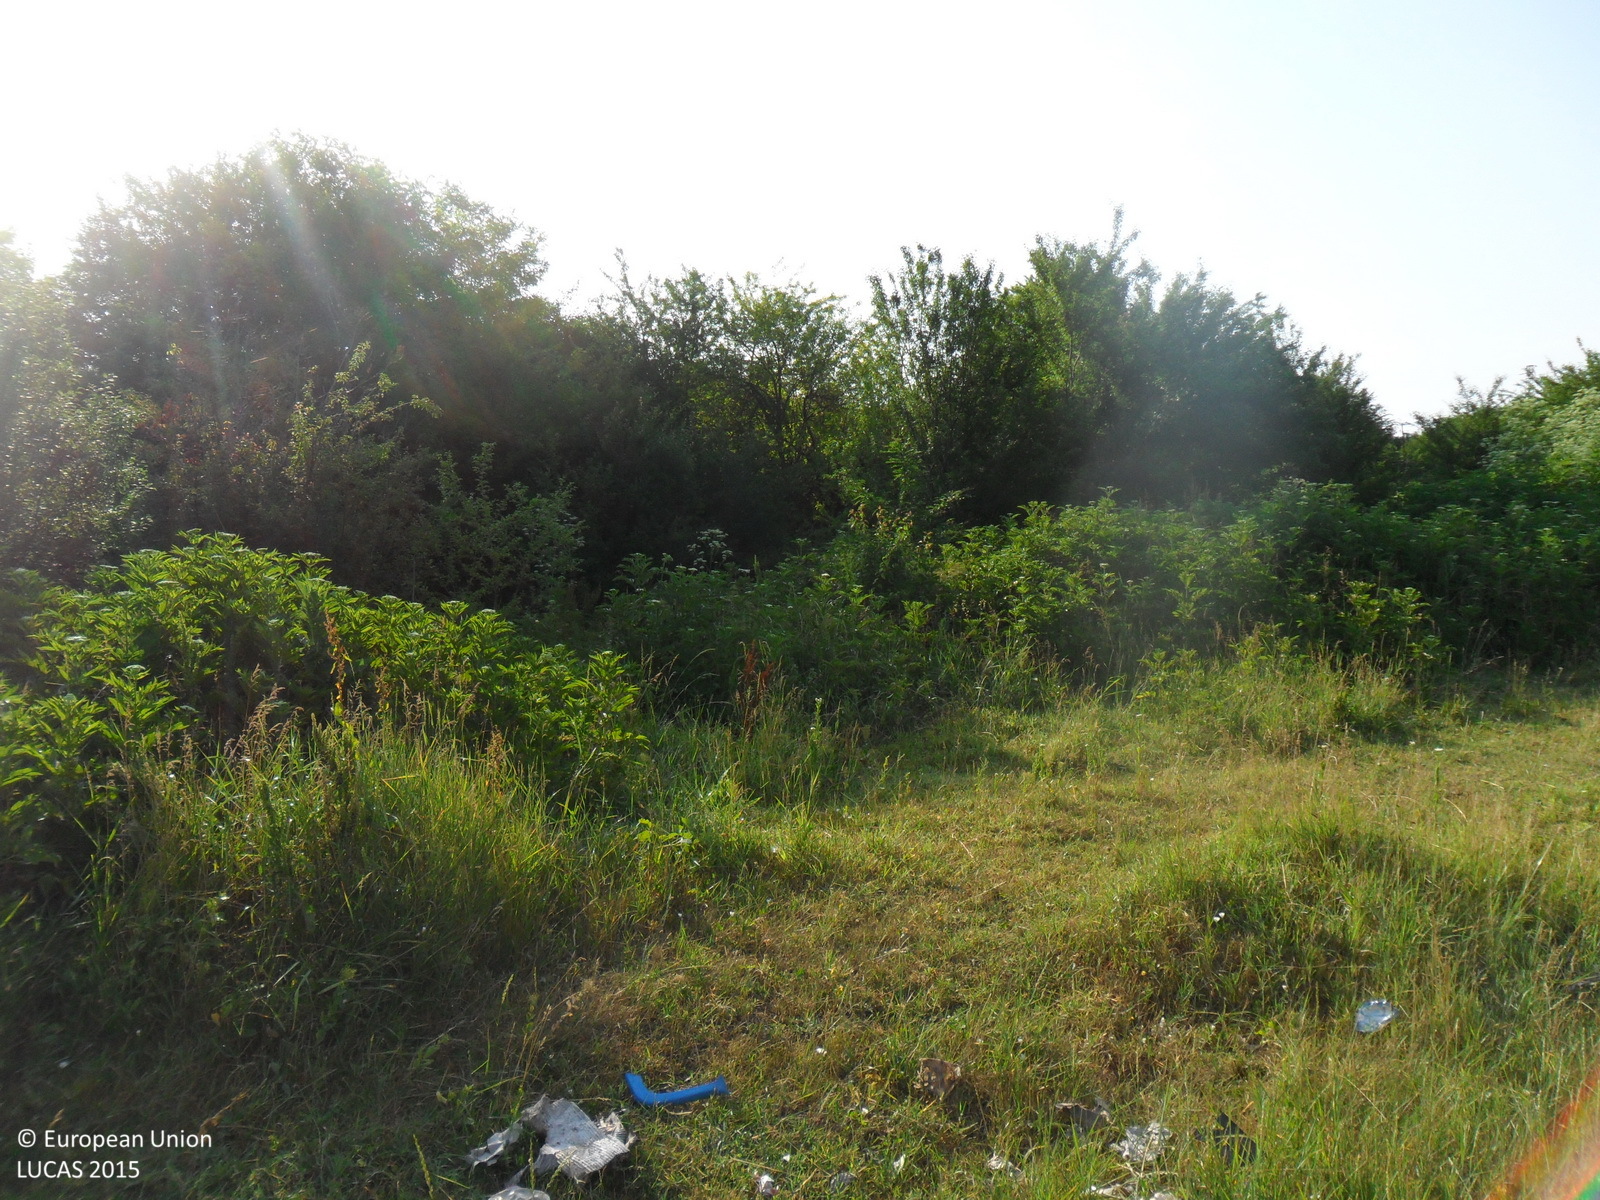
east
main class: Grassland
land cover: Grassland with sparse tree/shrub cover
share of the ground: > 75 %
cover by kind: herbaceous plants 90 %, broadleaved forest trees 5 %, shrubs 5 %
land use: Agriculture (excluding fallow land and kitchen gardens)
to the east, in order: Grassland with sparse tree/shrub cover; Broadleaved woodland; Grass margins; Paved roads, cycling and walking lanes; Grassland without tree/shrub cover; Electric lines; Grassland without tree/shrub cover; Single bushes/trees; Other fresh vegetables
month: June
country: BG
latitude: 43.6957
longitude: 26.8538
